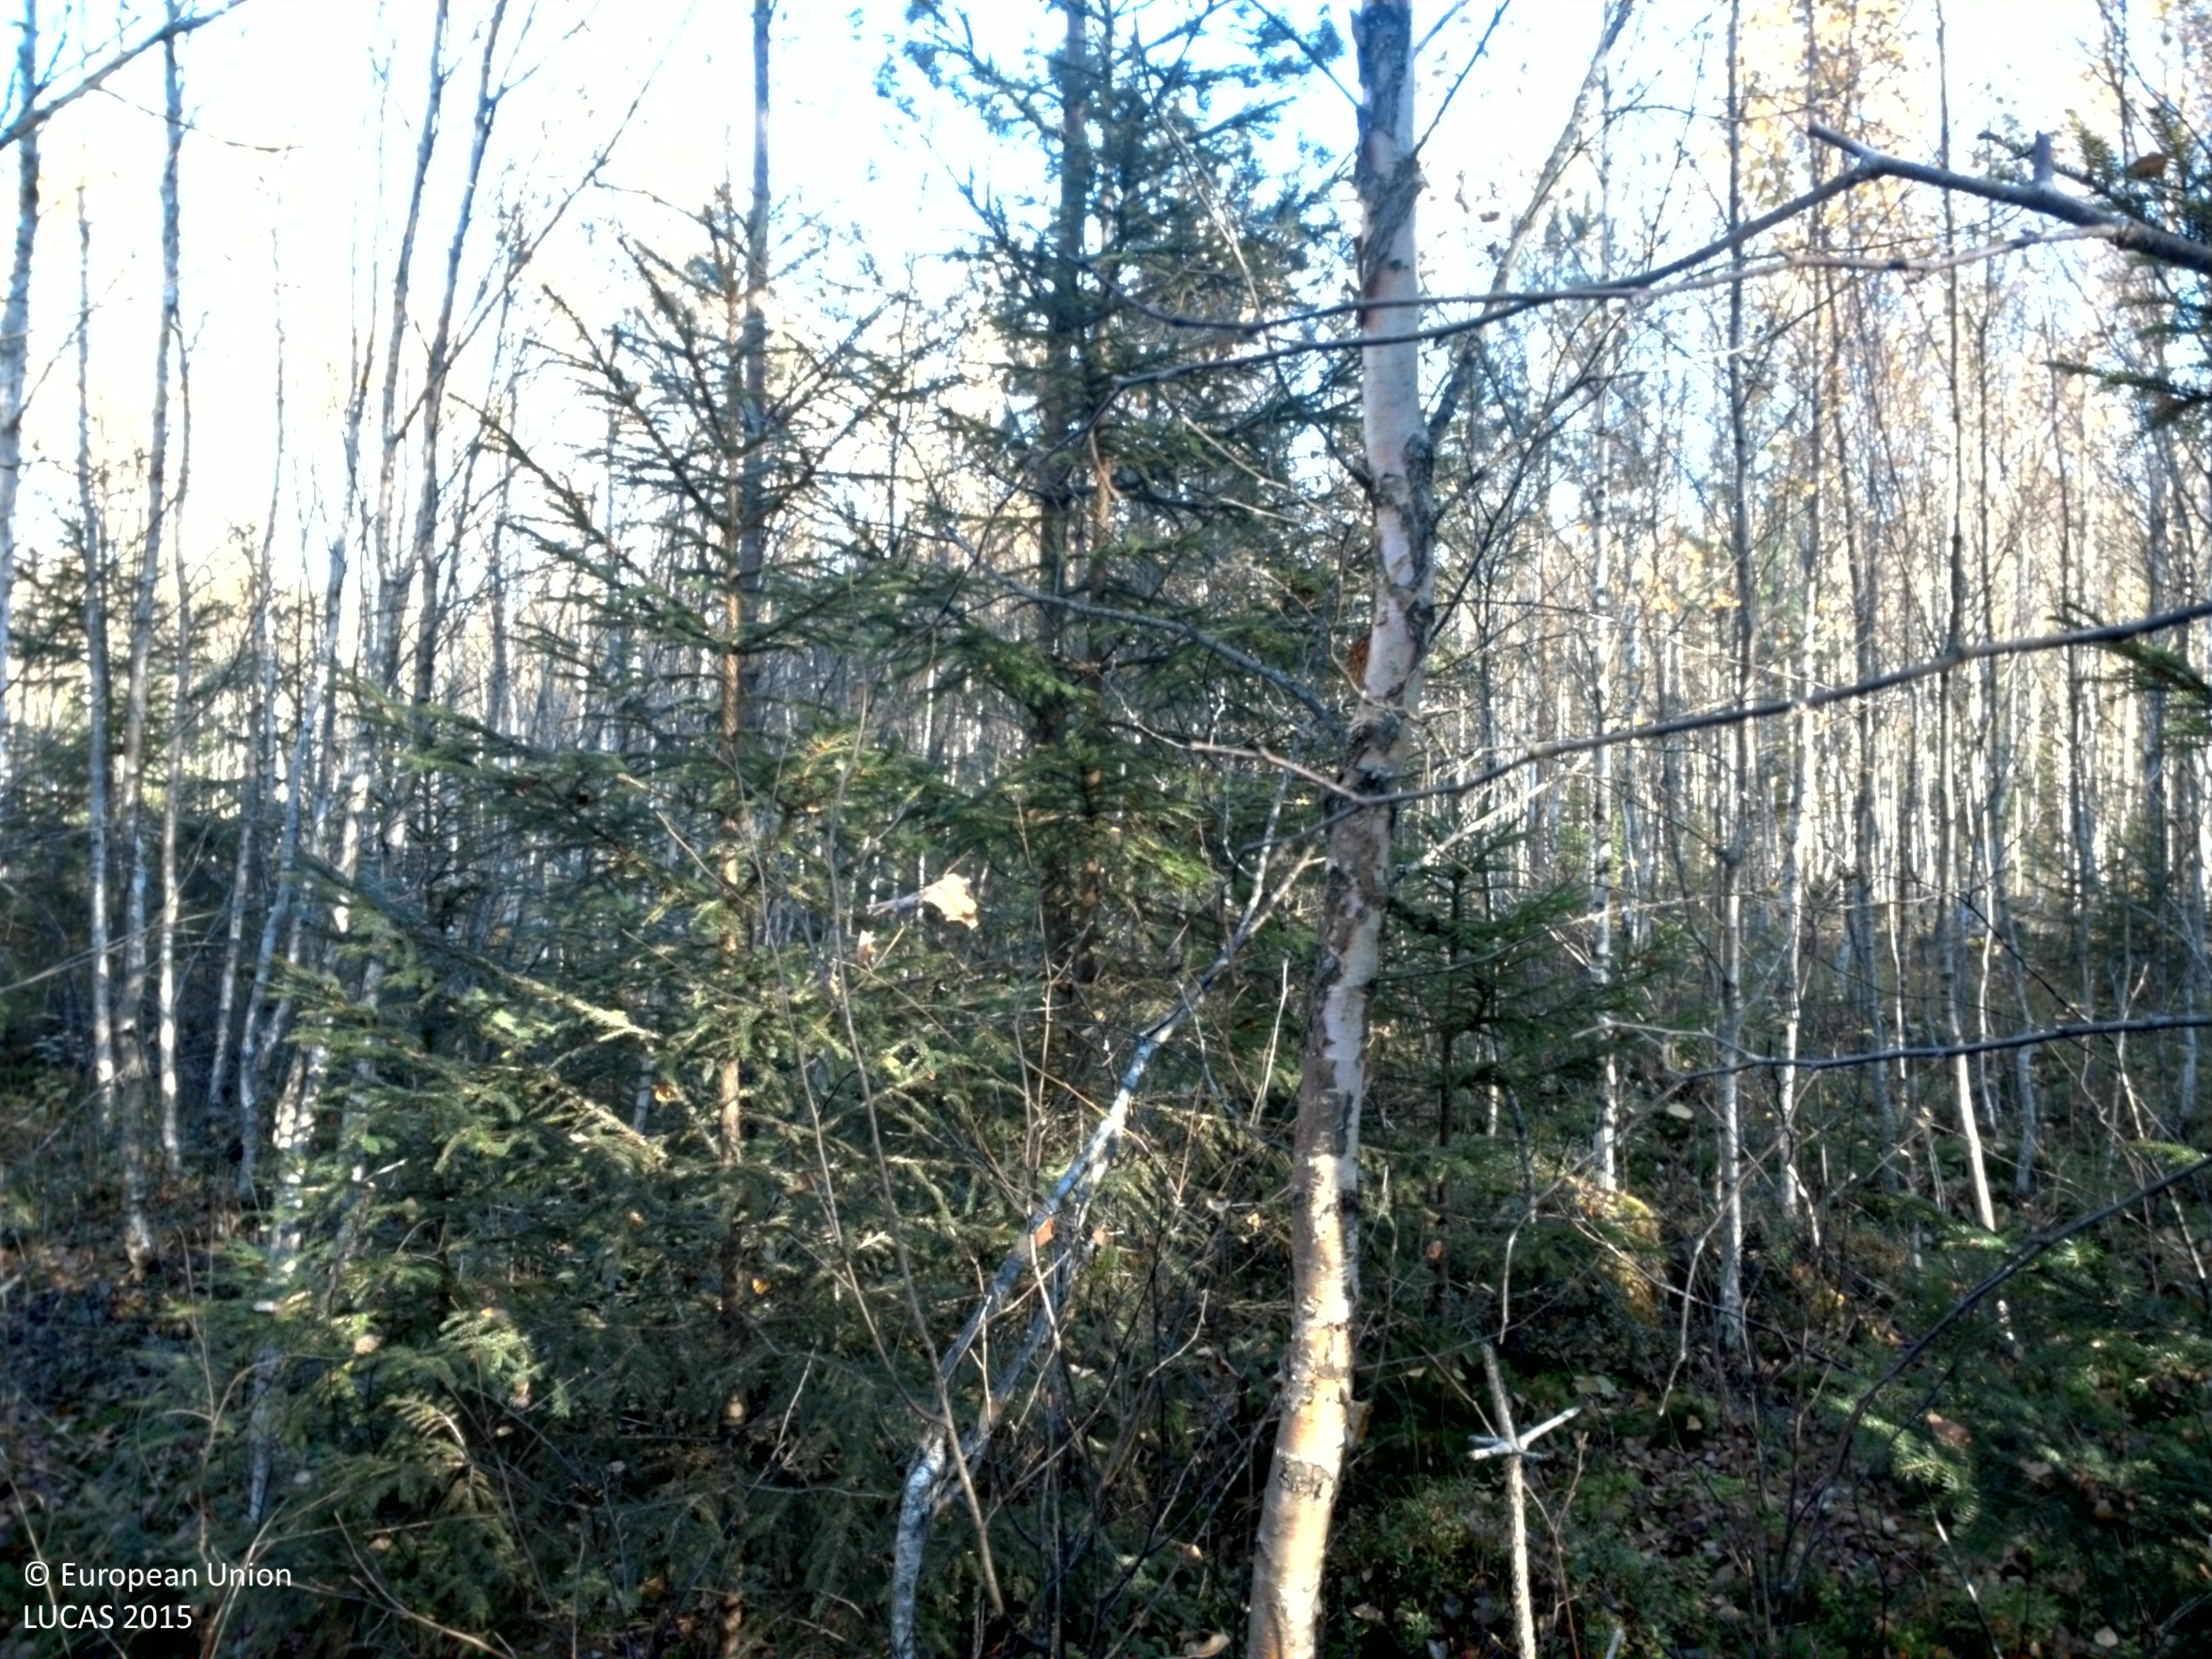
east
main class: Woodland
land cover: Spruce dominated mixed woodland
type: boreal forest
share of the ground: 25 - 50 %
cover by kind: broadleaved forest trees 35 %, herbaceous plants 20 %, lichens and mosses 20 %, coniferous forest trees 15 %, shrubs 10 %
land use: Forestry
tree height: > 5 m
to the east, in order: Spruce dominated mixed woodland; Ditches and canals; Grassland without tree/shrub cover; Spruce dominated coniferous woodland; Broadleaved woodland; Ditches and canals; Broadleaved woodland; Grass margins; Barley
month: October
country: SE
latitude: 59.1007
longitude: 13.1531
